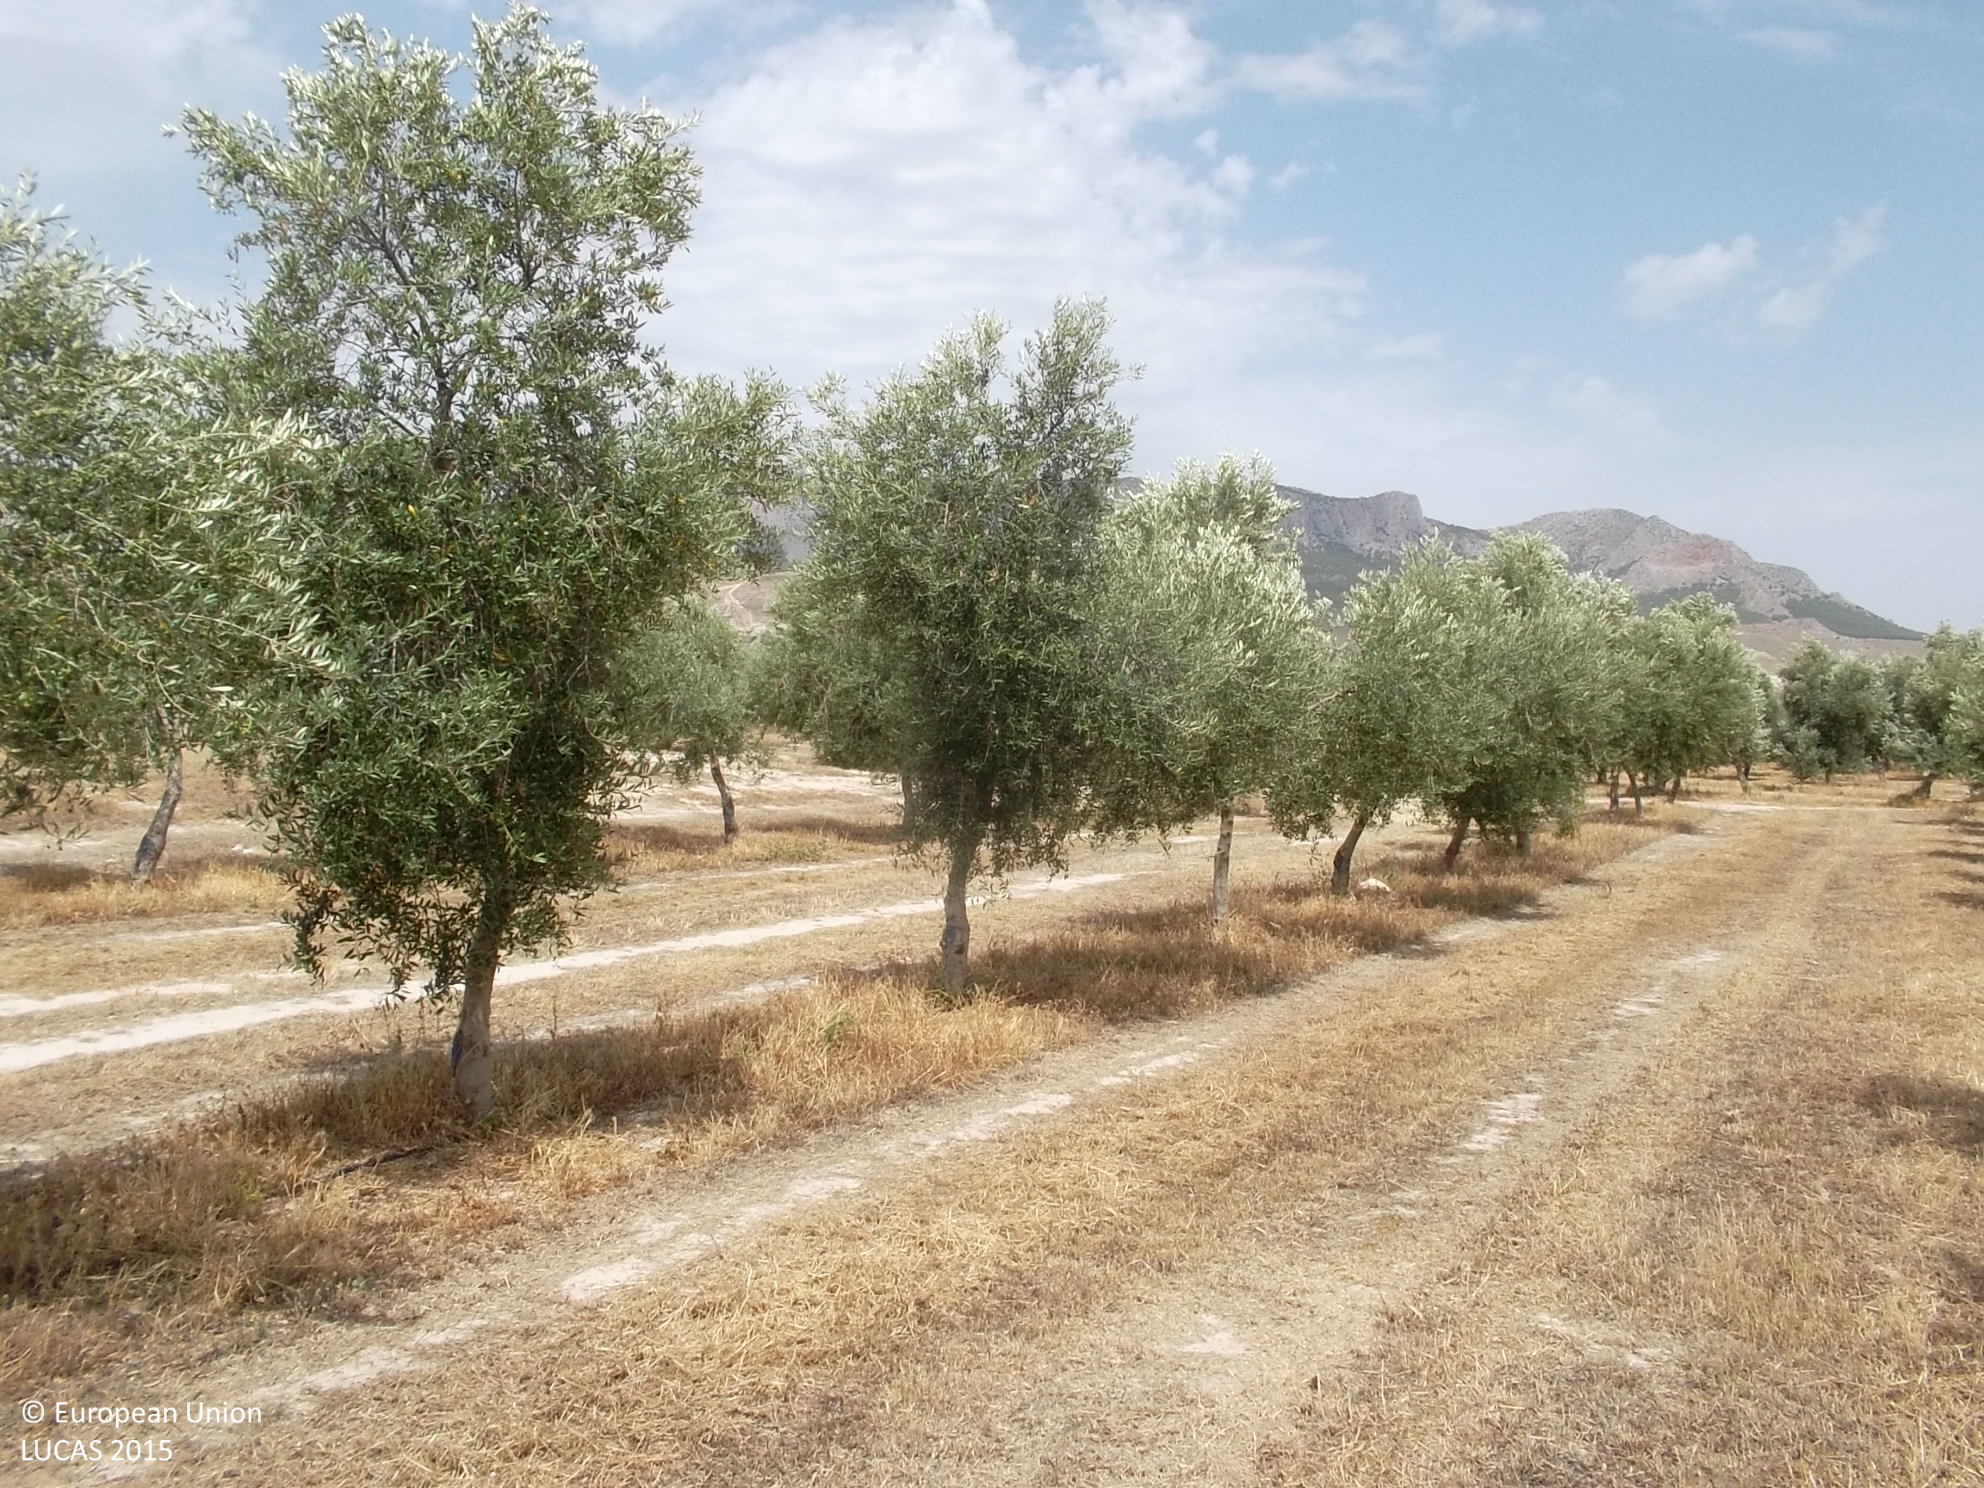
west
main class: Cropland
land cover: Olive groves
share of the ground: 50 - 75 %
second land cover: Spontaneously vegetated surfaces
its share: > 75 %
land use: Agriculture (excluding fallow land and kitchen gardens)
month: July
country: ES
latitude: 37.5434
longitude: -2.7659
